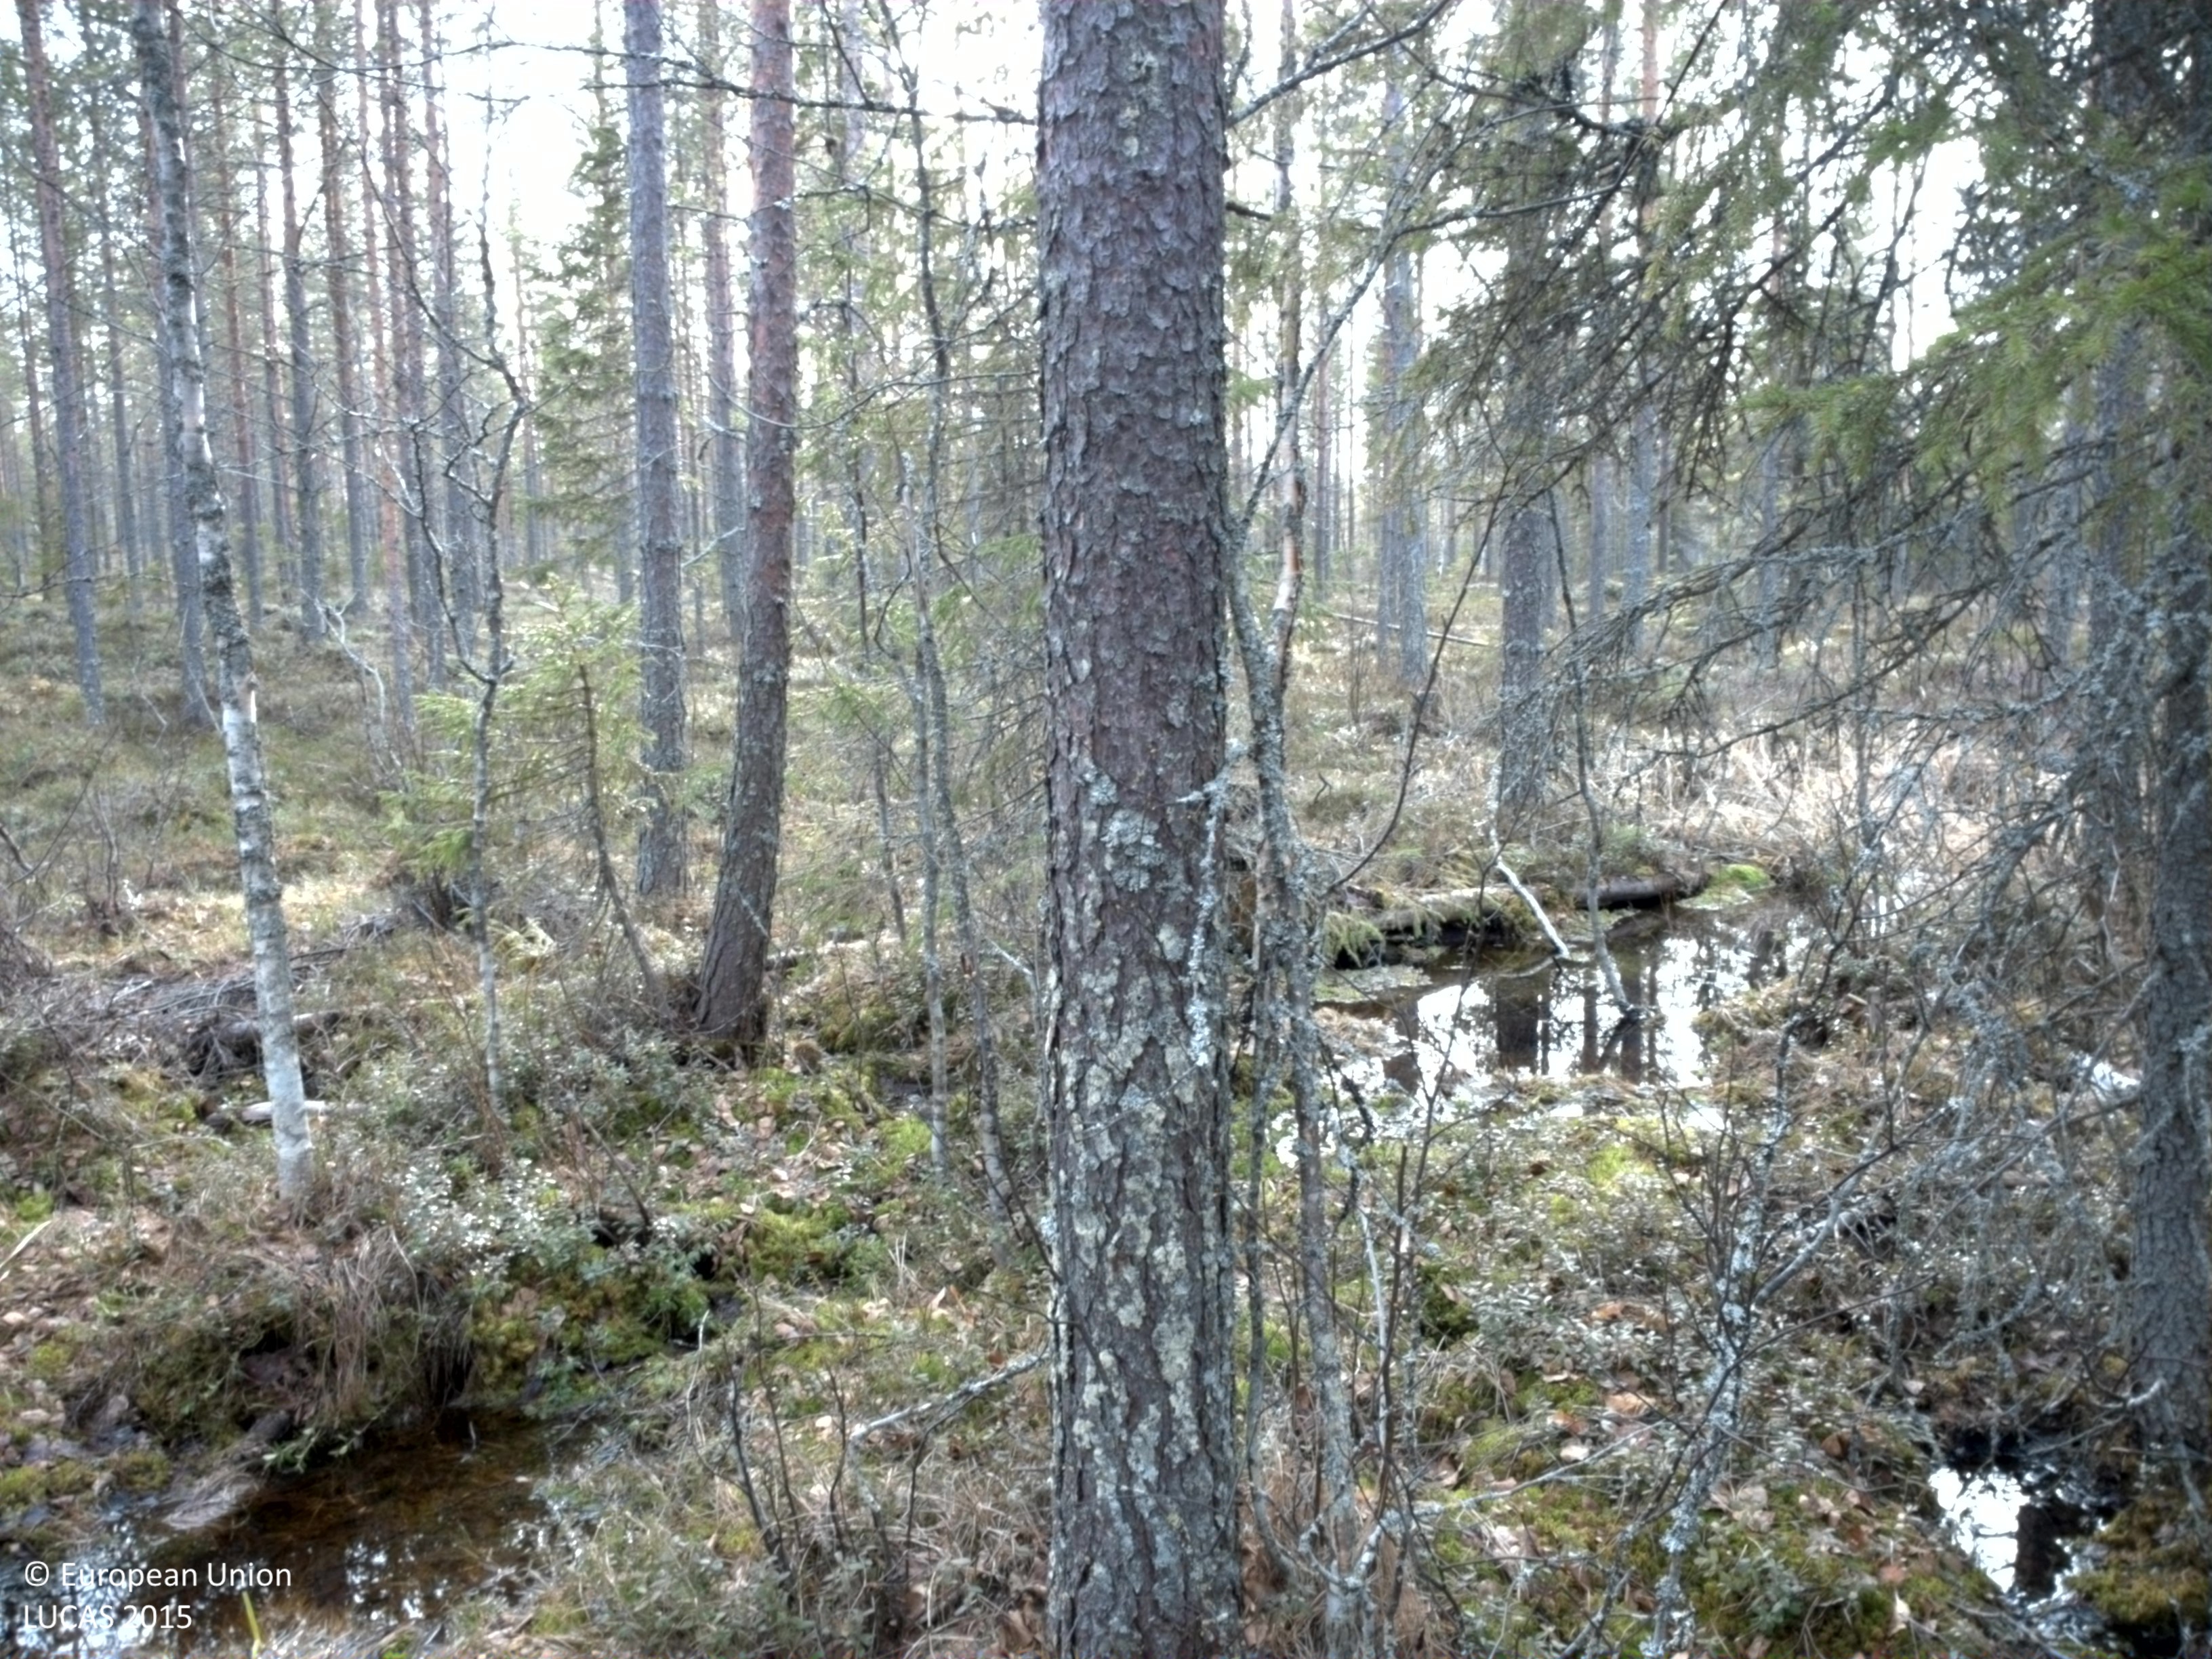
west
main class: Woodland
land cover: Pine dominated mixed woodland
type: mire and swamp forests
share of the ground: > 75 %
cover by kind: coniferous forest trees 65 %, broadleaved forest trees 25 %, shrubs 10 %
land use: Forestry
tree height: > 5 m
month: May
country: SE
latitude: 65.8484
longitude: 23.6409
